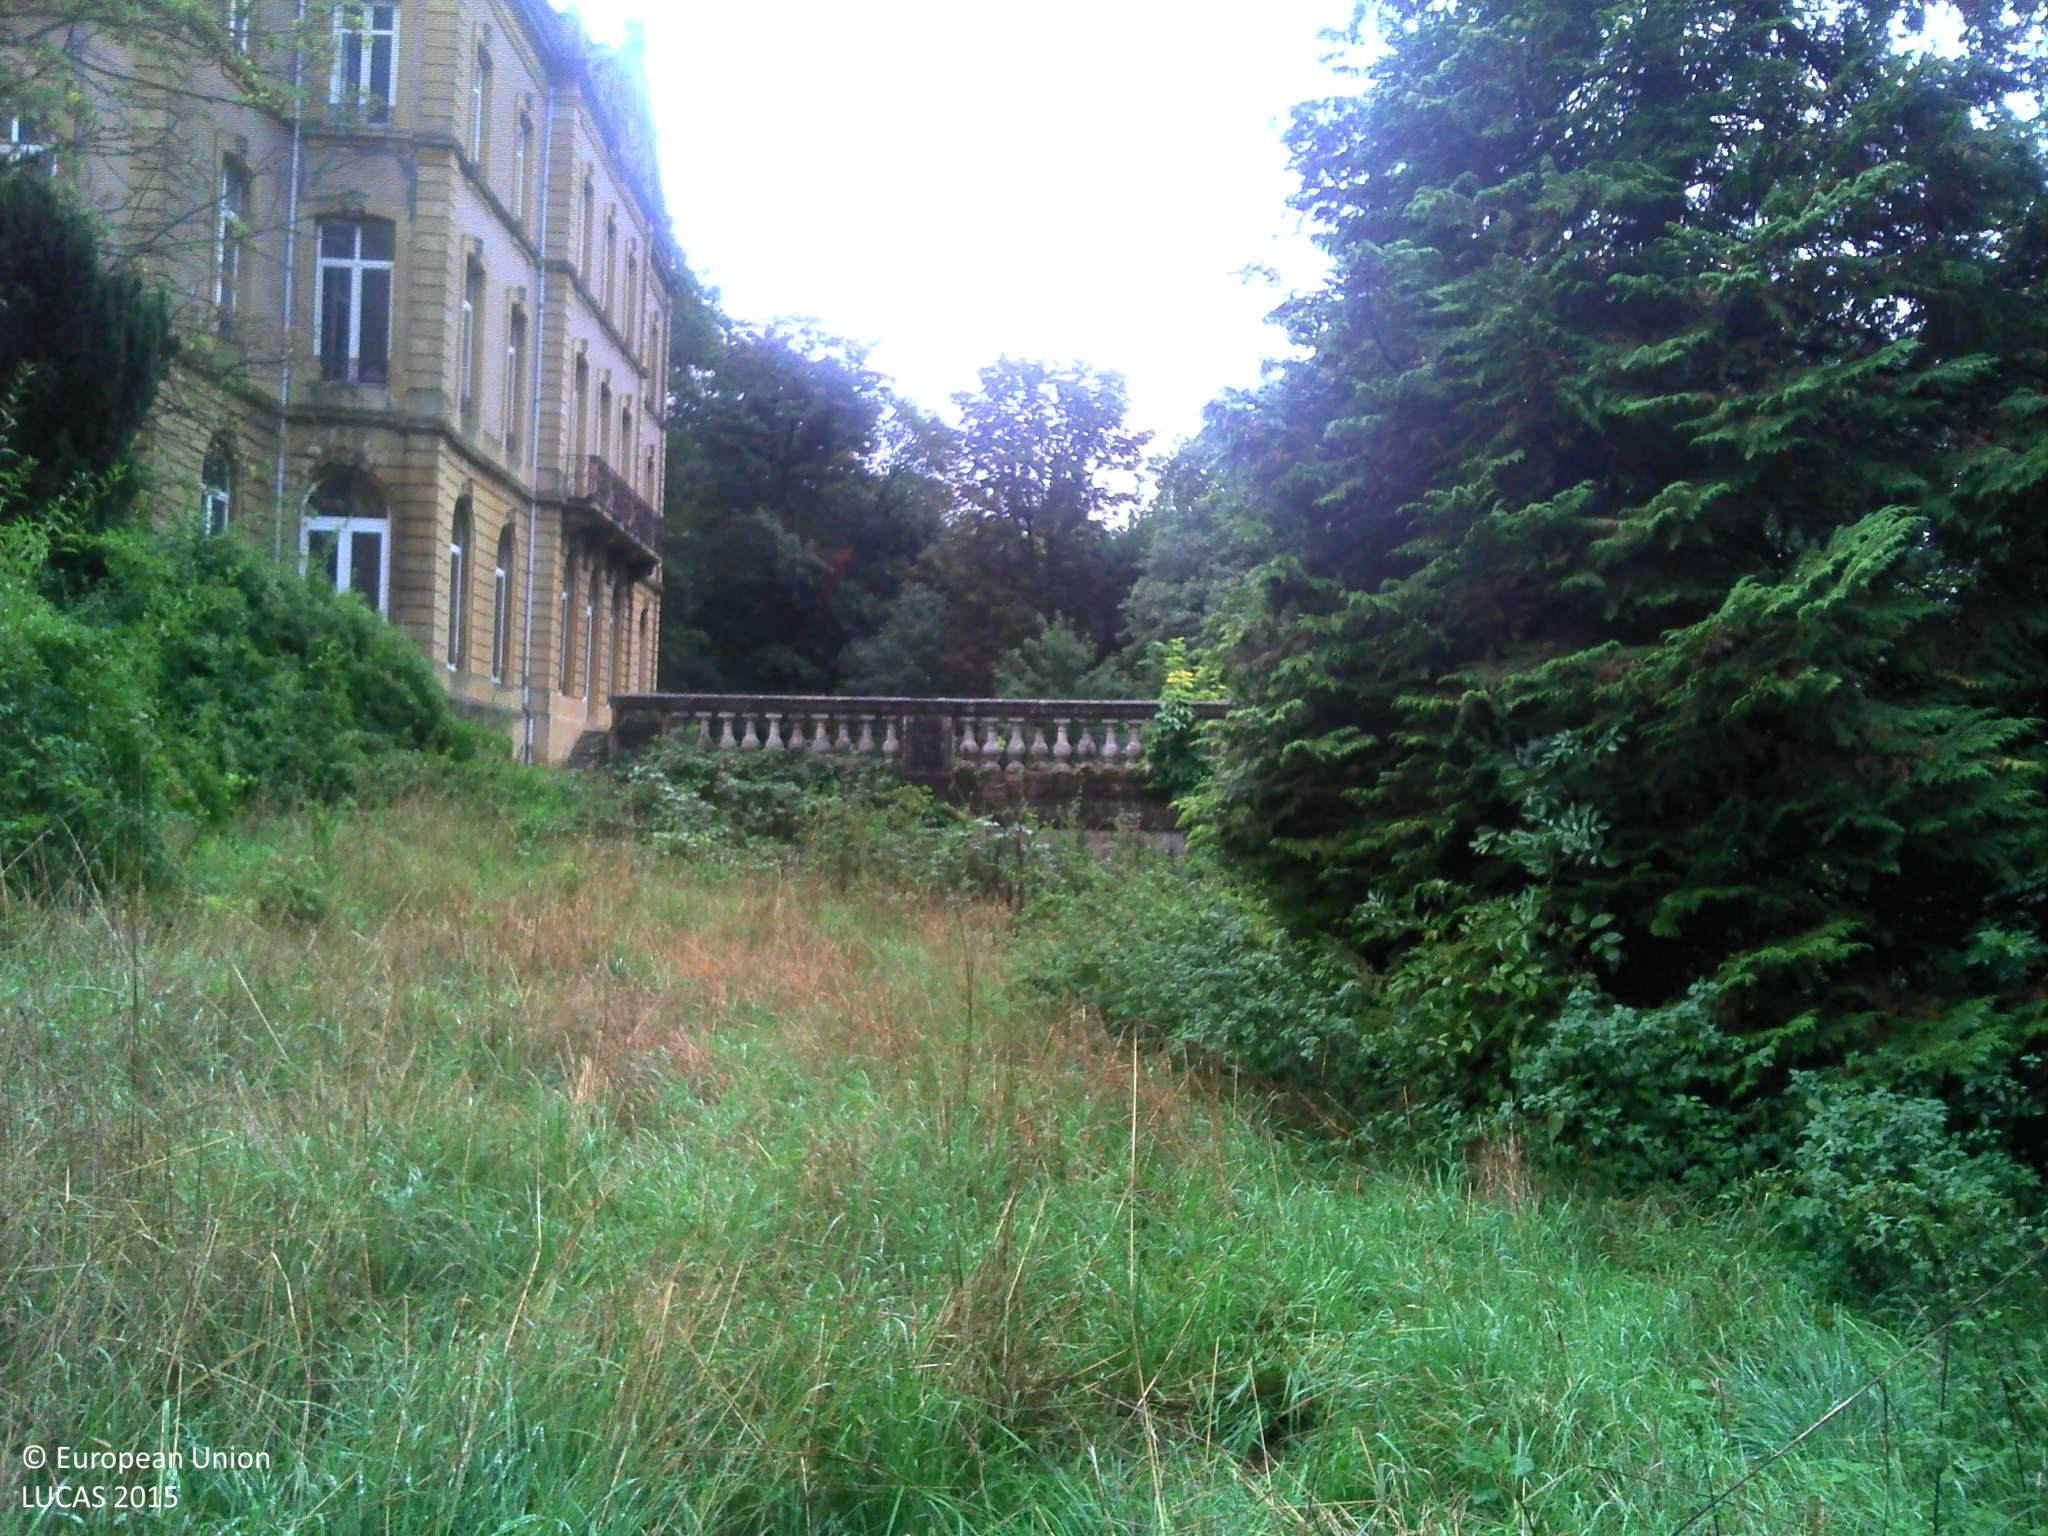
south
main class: Grassland
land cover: Grassland with sparse tree/shrub cover
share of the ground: > 75 %
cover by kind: herbaceous plants 85 %, consolidated bare surface 10 %, broadleaved forest trees 5 %
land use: Community services
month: September
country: FR
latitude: 48.7338
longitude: 6.1794
